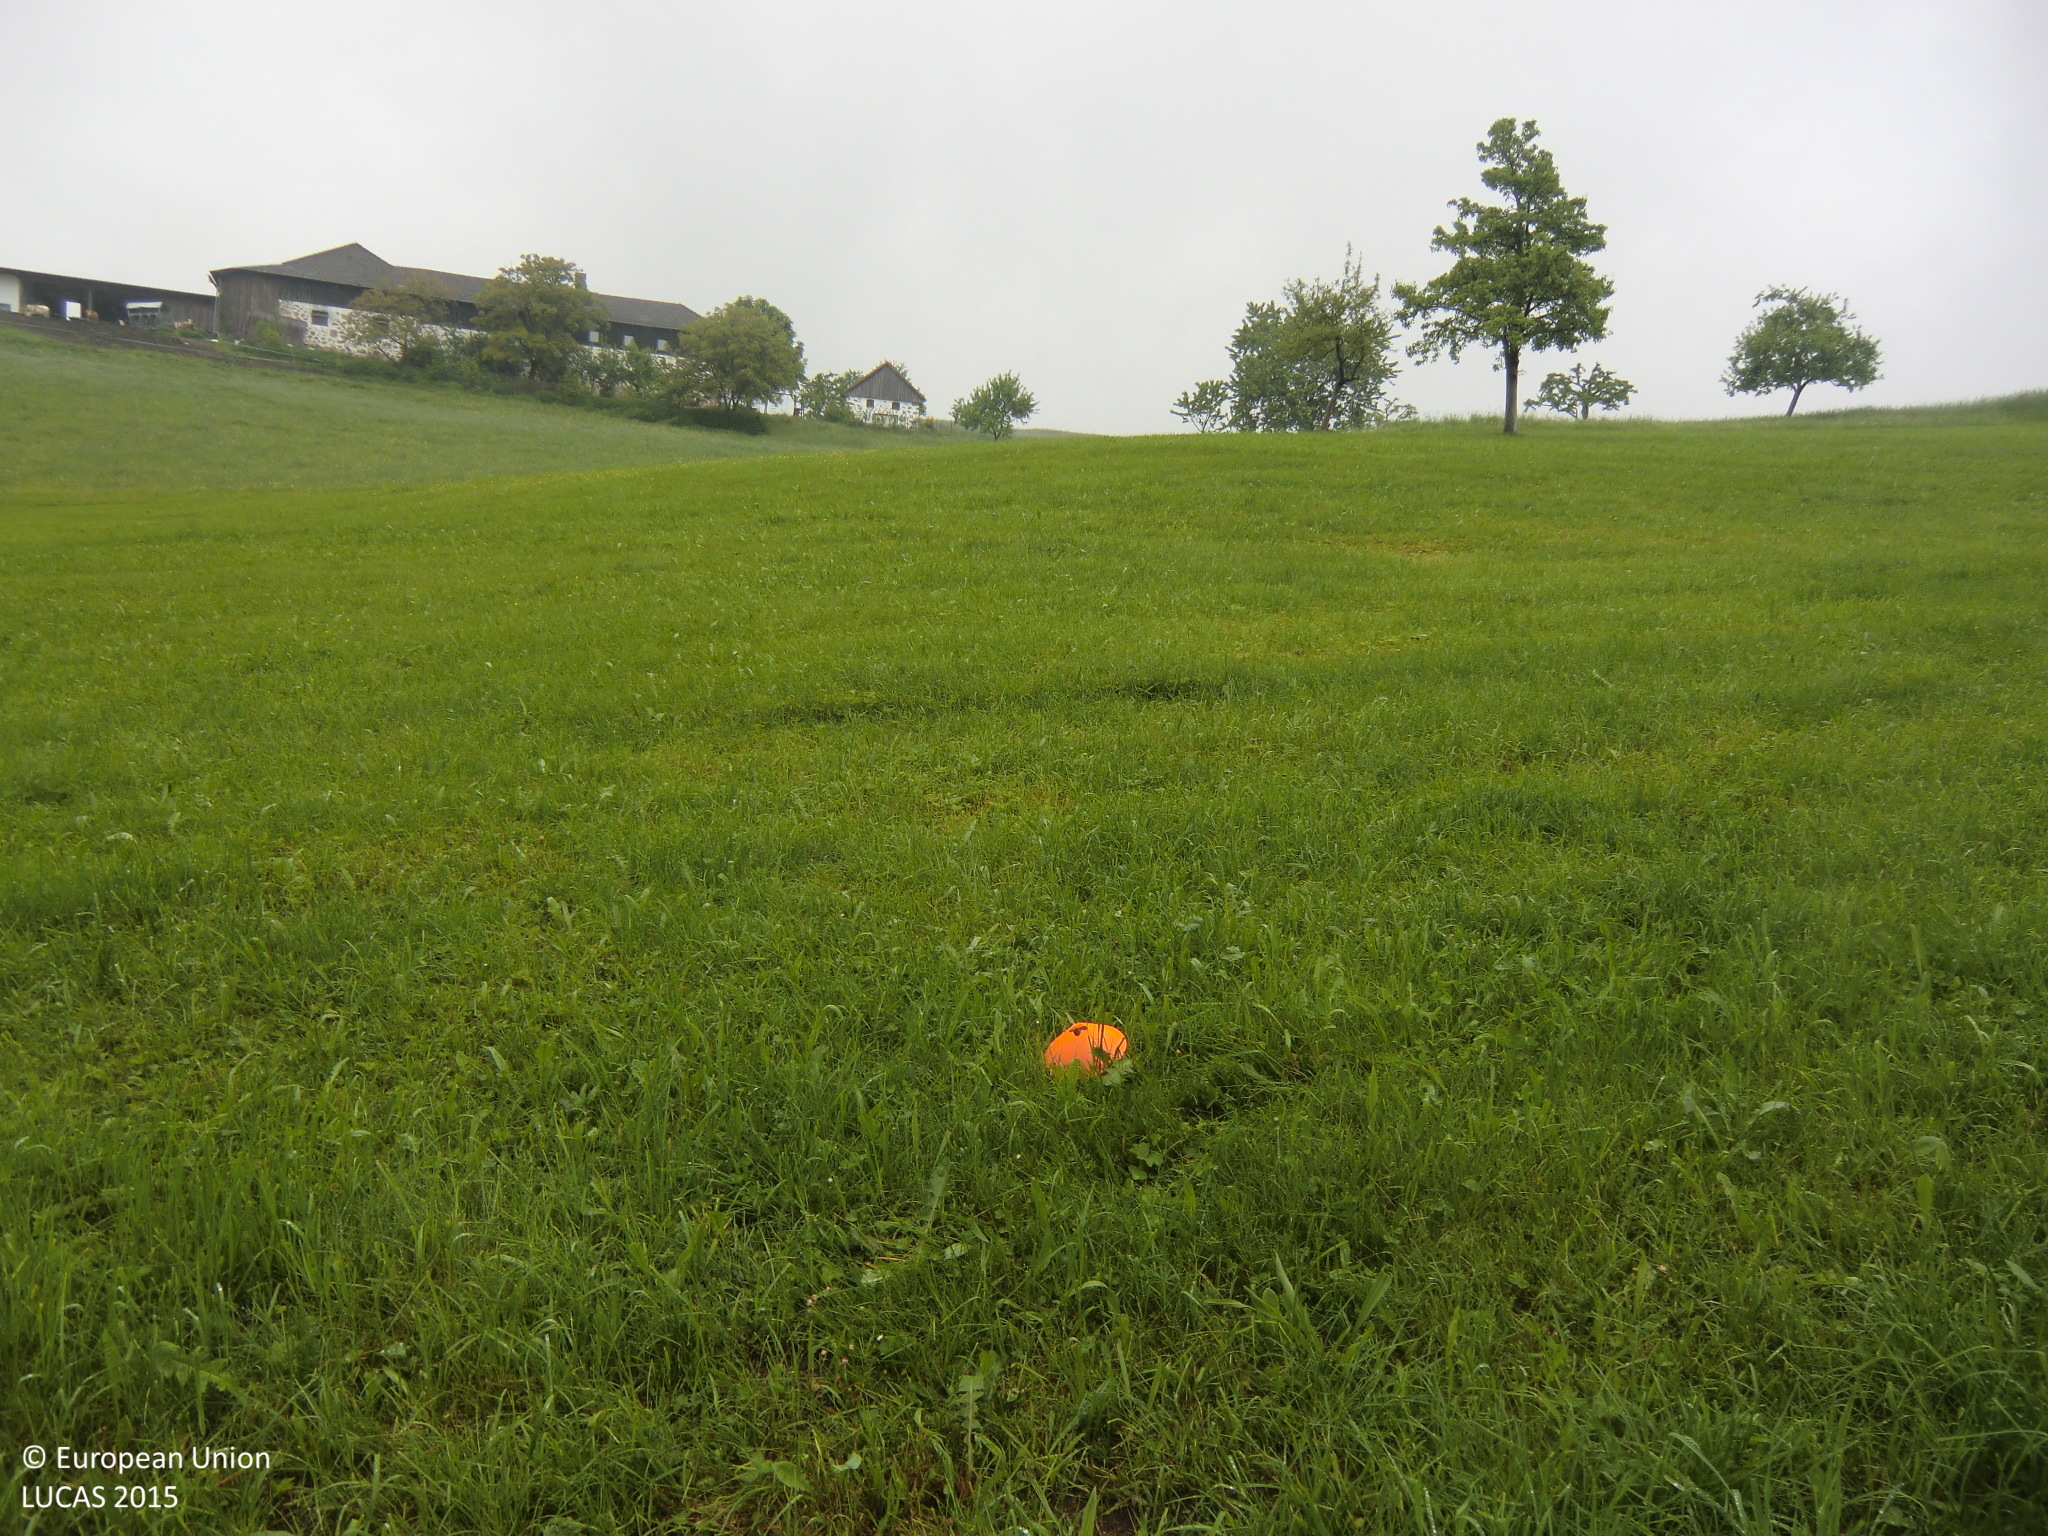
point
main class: Grassland
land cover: Grassland without tree/shrub cover
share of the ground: > 75 %
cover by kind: herbaceous plants 100 %
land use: Agriculture (excluding fallow land and kitchen gardens)
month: May
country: AT
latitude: 48.3988
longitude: 14.5795
